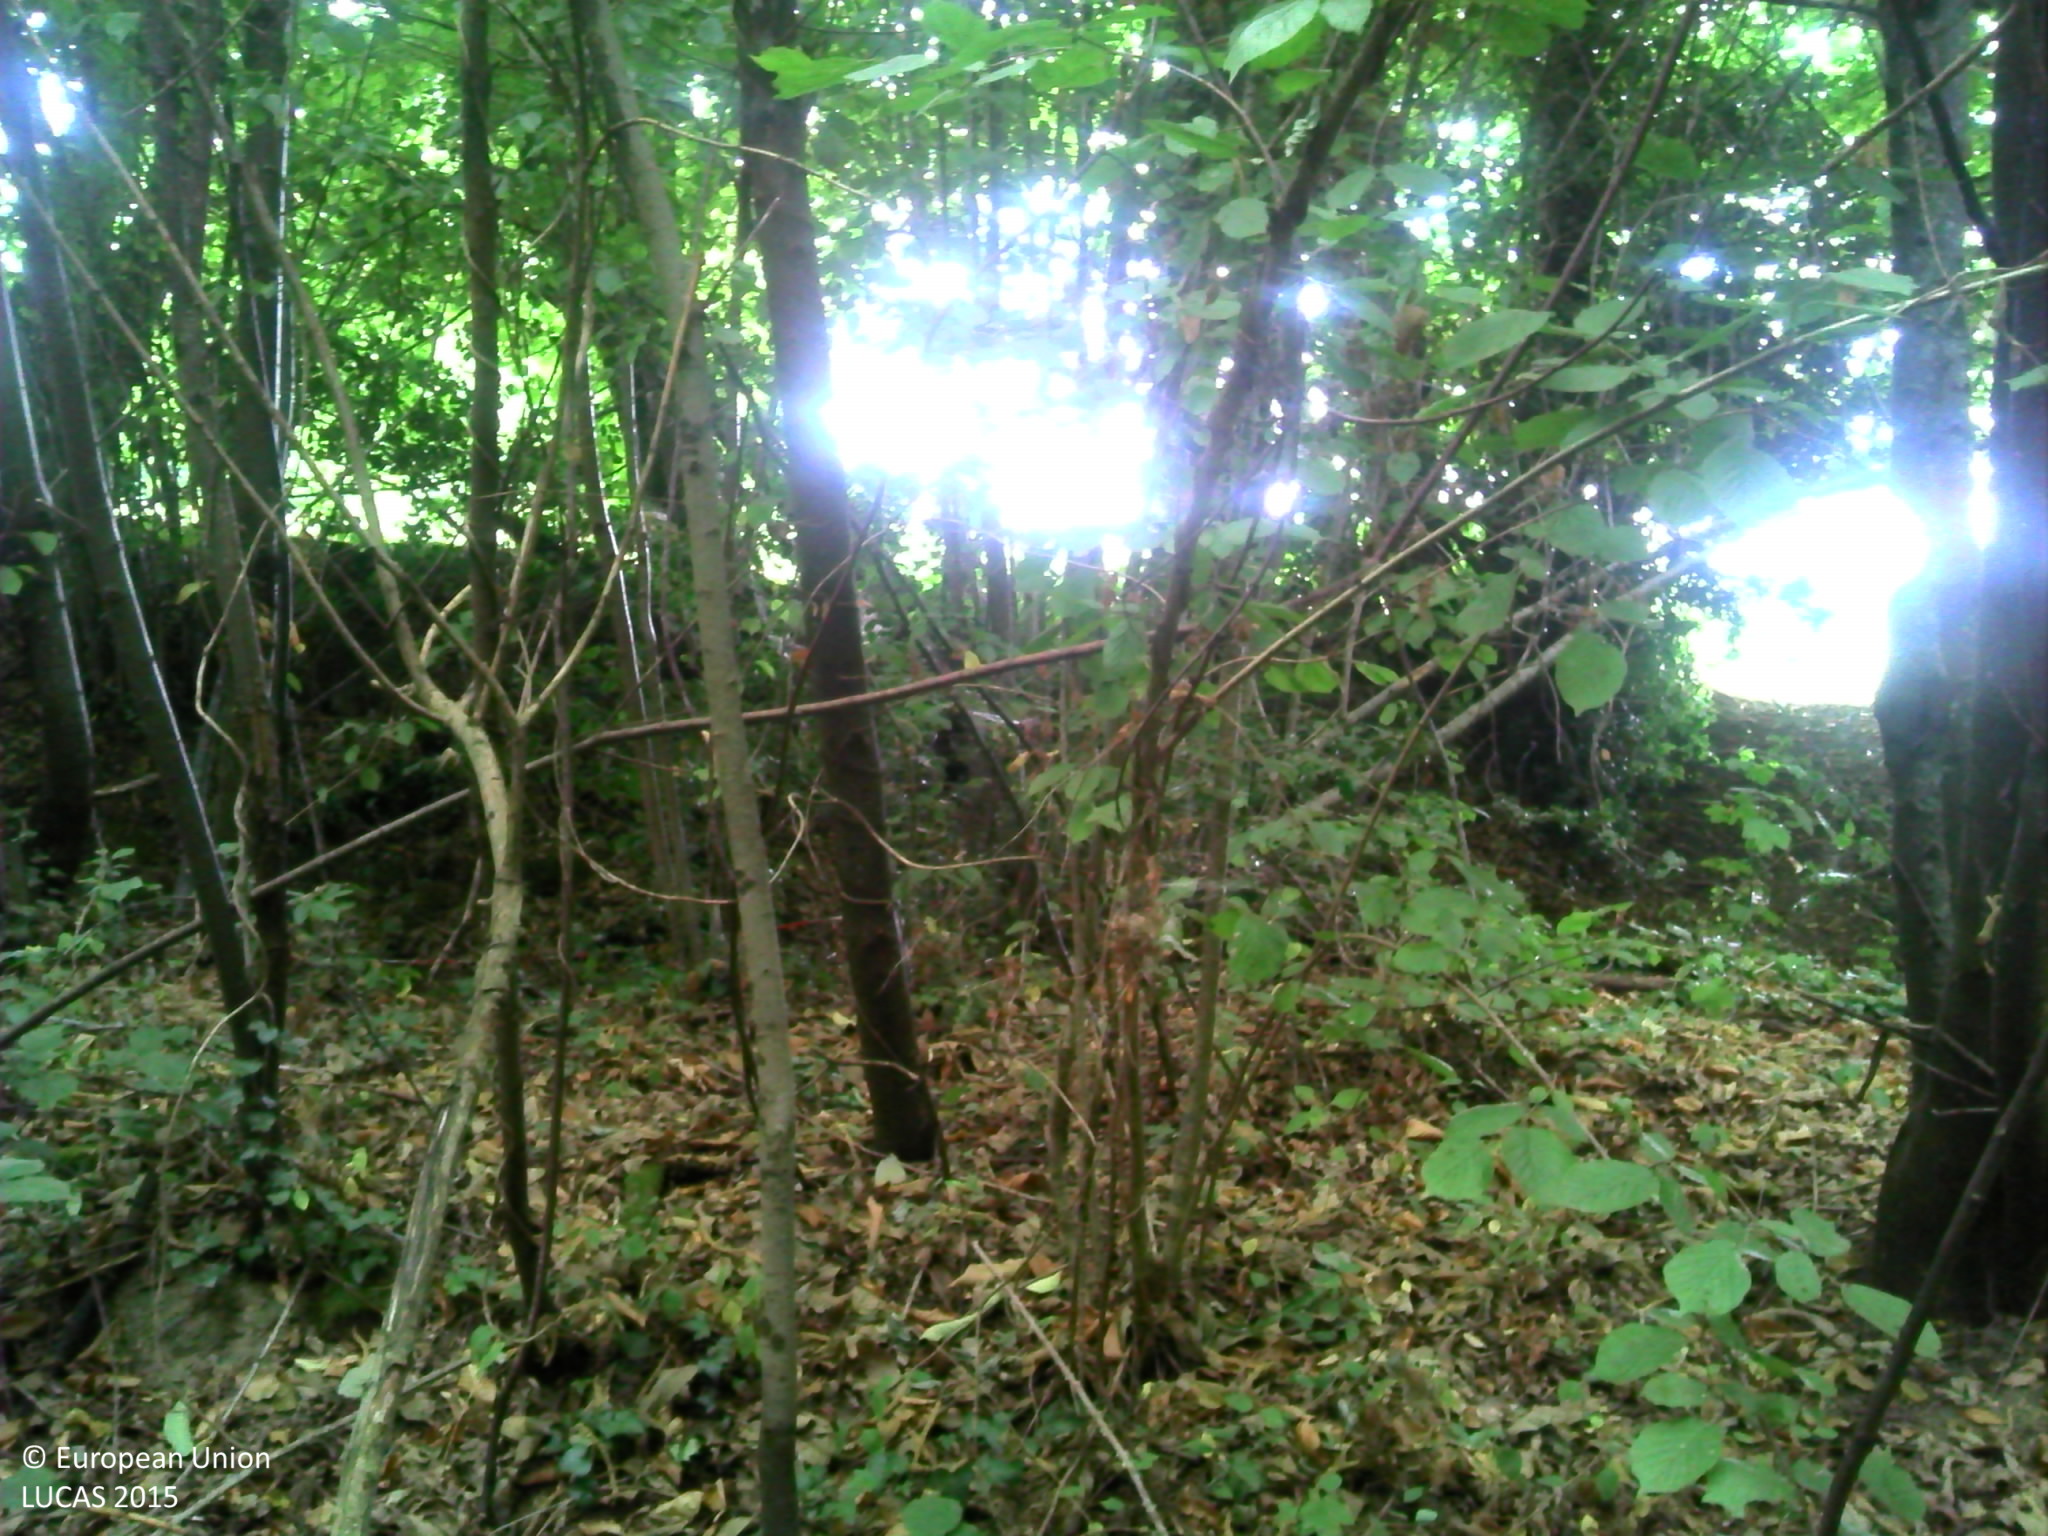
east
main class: Woodland
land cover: Broadleaved woodland
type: thermophilous deciduous forest
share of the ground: > 75 %
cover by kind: broadleaved forest trees 90 %, herbaceous plants 10 %
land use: Semi-natural and natural areas not in use
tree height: > 5 m
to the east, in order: Broadleaved woodland; Tracks; Broadleaved woodland; Grassland with sparse tree/shrub cover; Artificial constructions in urban areas; Grassland without tree/shrub cover; Electric lines; Grassland without tree/shrub cover; Managed hedges
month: July
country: FR
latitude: 45.3704
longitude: 1.4005
